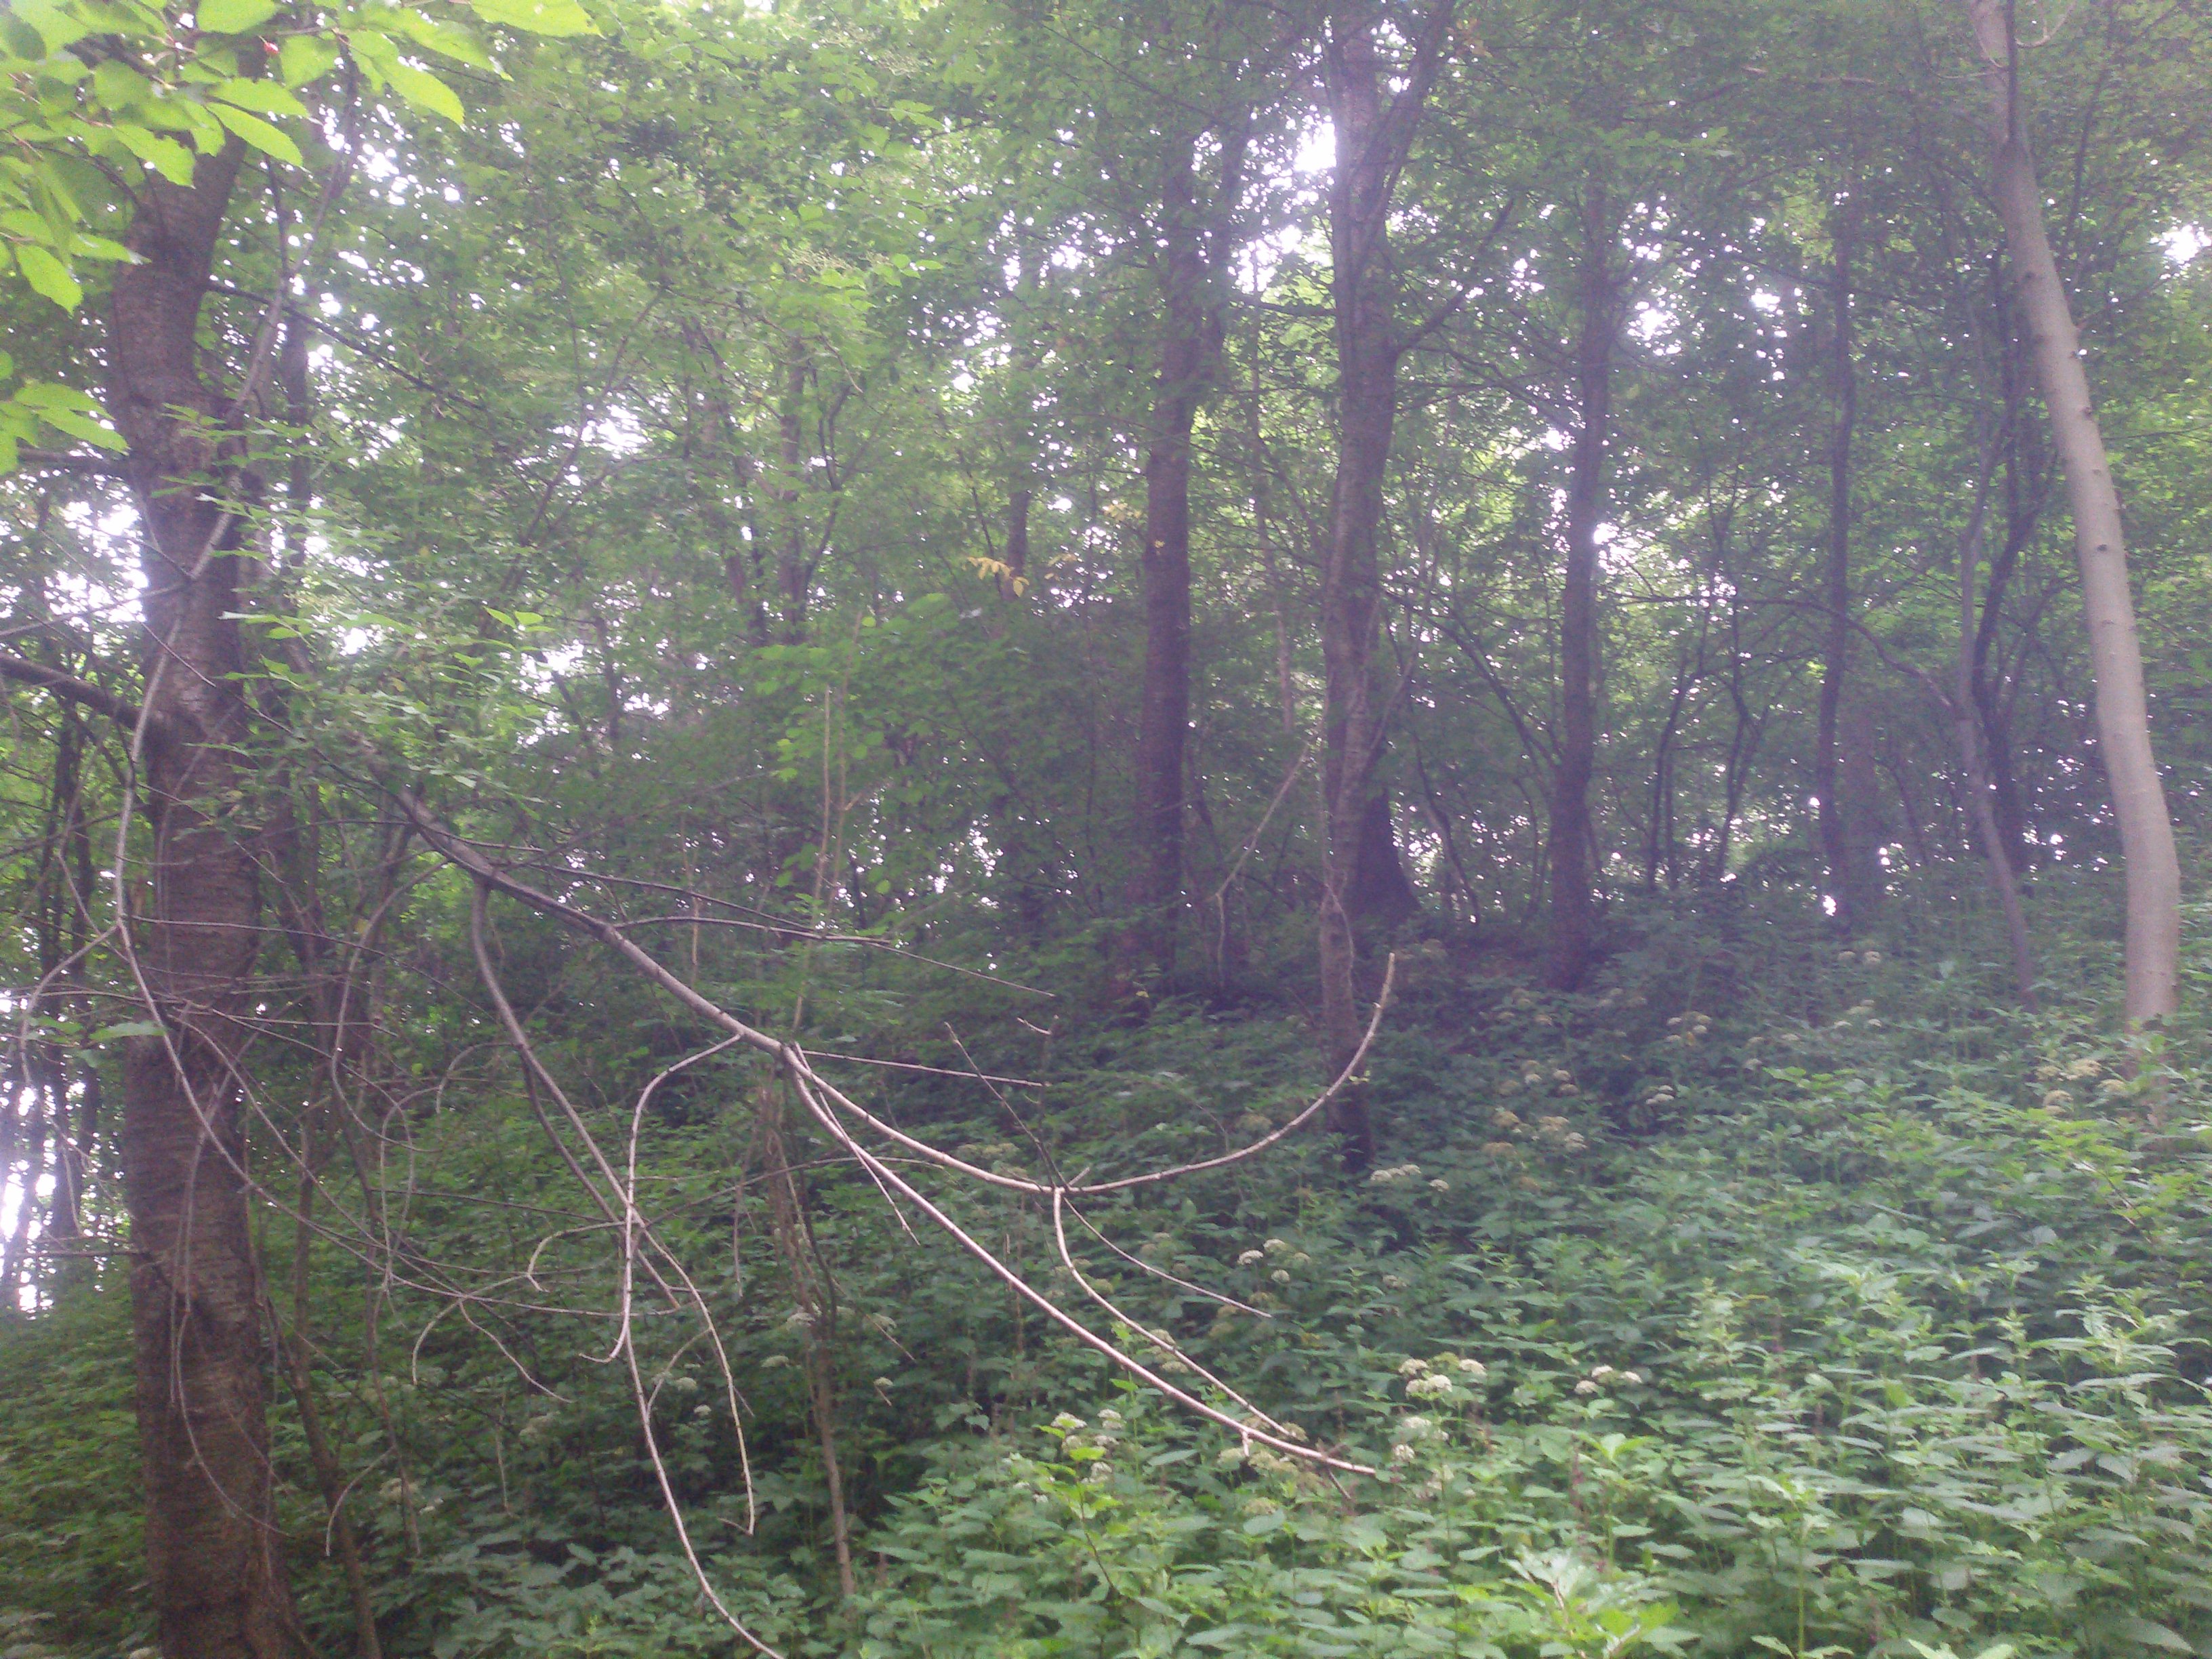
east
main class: Woodland
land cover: Broadleaved woodland
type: mesophytic deciduous forest
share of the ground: 50 - 75 %
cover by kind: broadleaved forest trees 65 %, herbaceous plants 25 %, shrubs 10 %
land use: Forestry
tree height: > 5 m
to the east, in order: Broadleaved woodland; Grassland without tree/shrub cover; Broadleaved woodland; Oats; Grassland without tree/shrub cover; Grassland with sparse tree/shrub cover
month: June
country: PL
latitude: 49.9328
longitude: 22.3079
